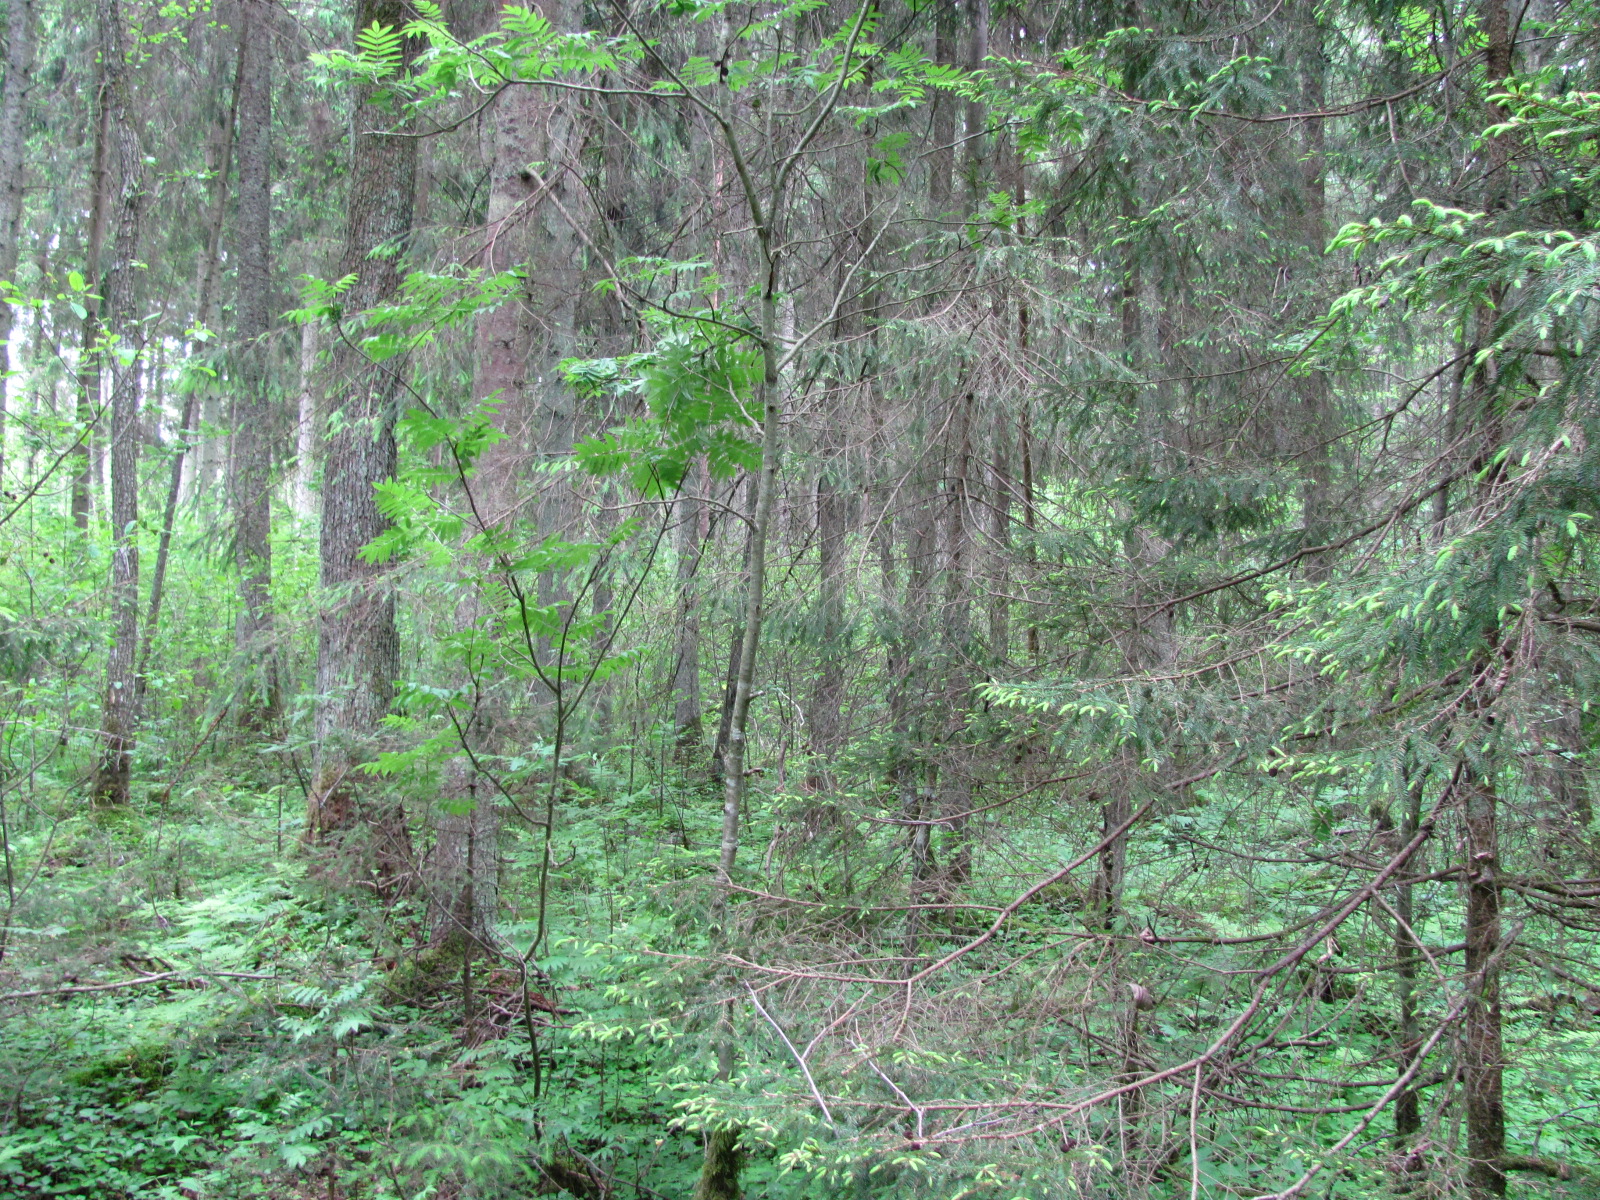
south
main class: Woodland
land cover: Spruce dominated mixed woodland
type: hemiboreal forest and nemoral coniferous forest and mixed broadleaved-coniferous forest
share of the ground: > 75 %
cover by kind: coniferous forest trees 50 %, broadleaved forest trees 50 %
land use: Forestry
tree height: > 5 m
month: June
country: LV
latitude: 56.8341
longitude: 24.0655
